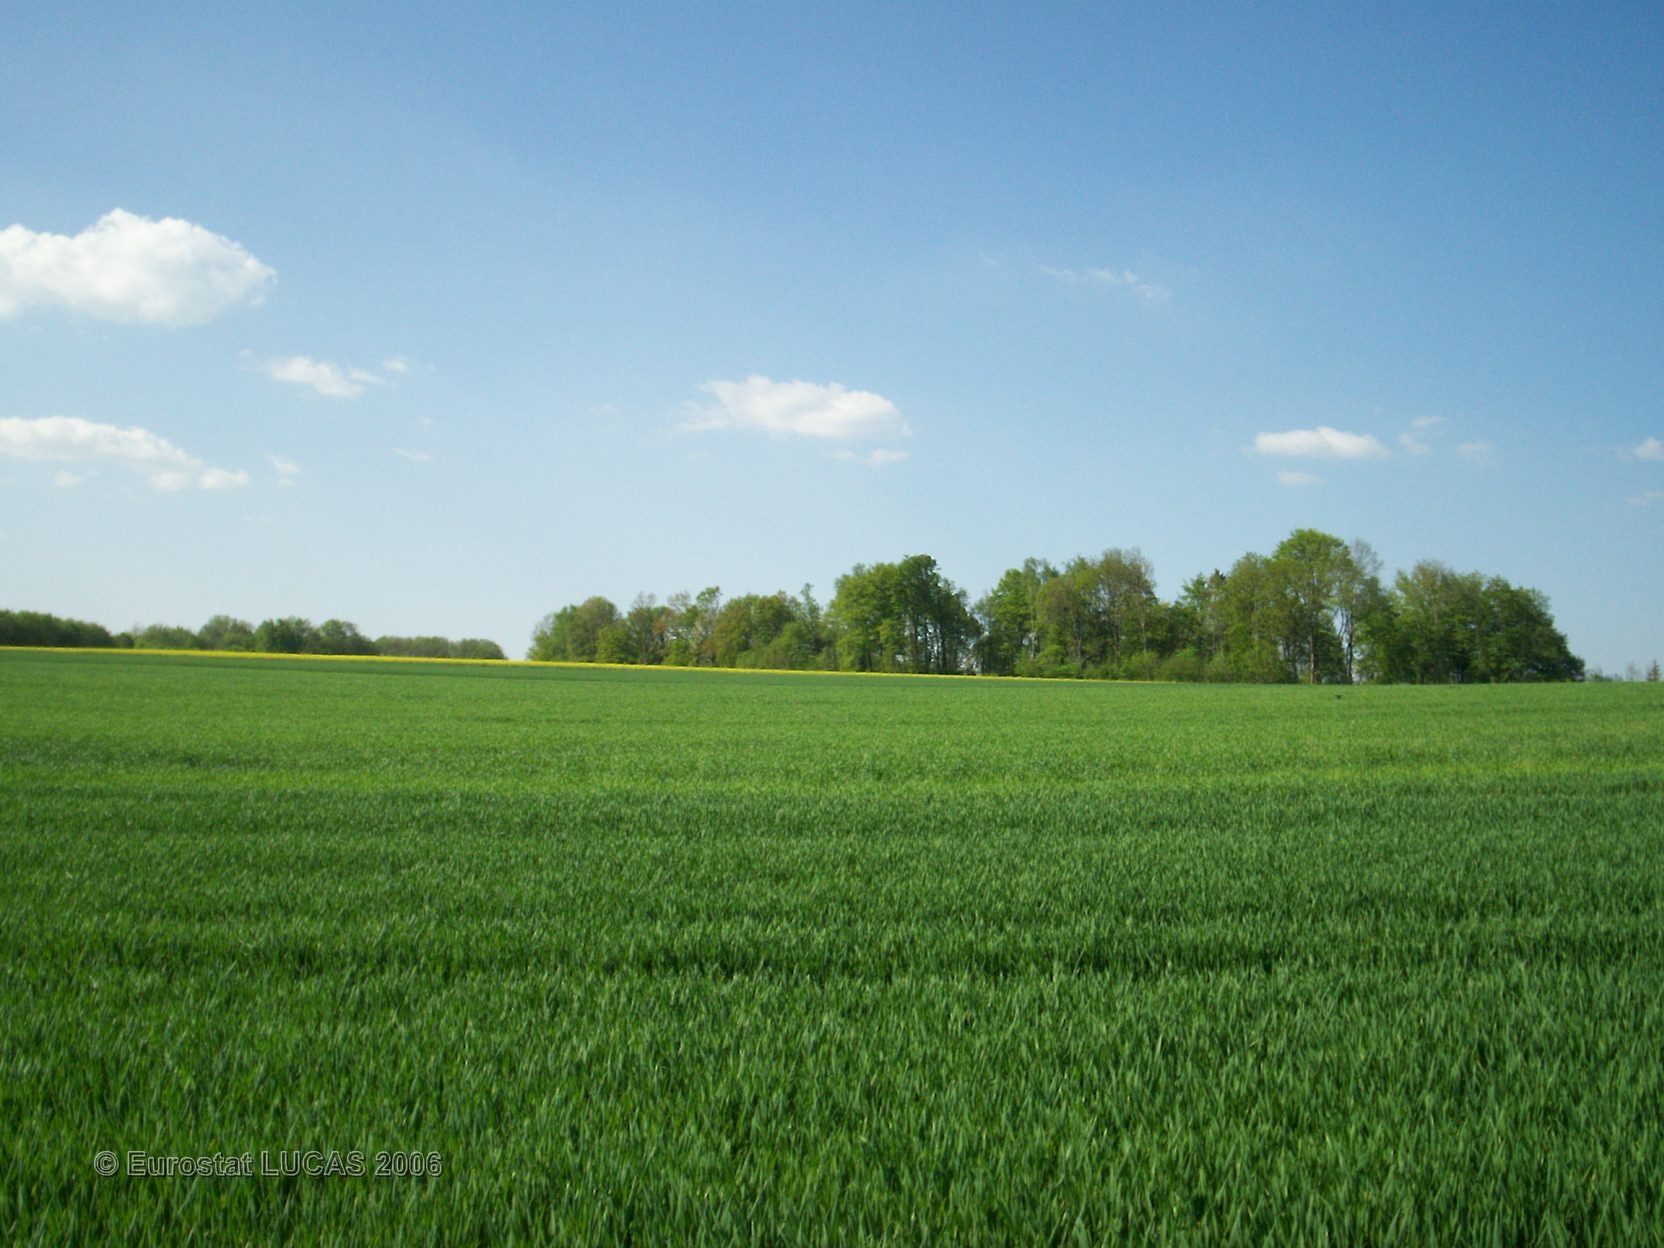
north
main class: Cropland
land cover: Common wheat
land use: Agriculture (excluding fallow land and kitchen gardens)
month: May
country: FR
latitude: 49.7151
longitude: 5.0185
